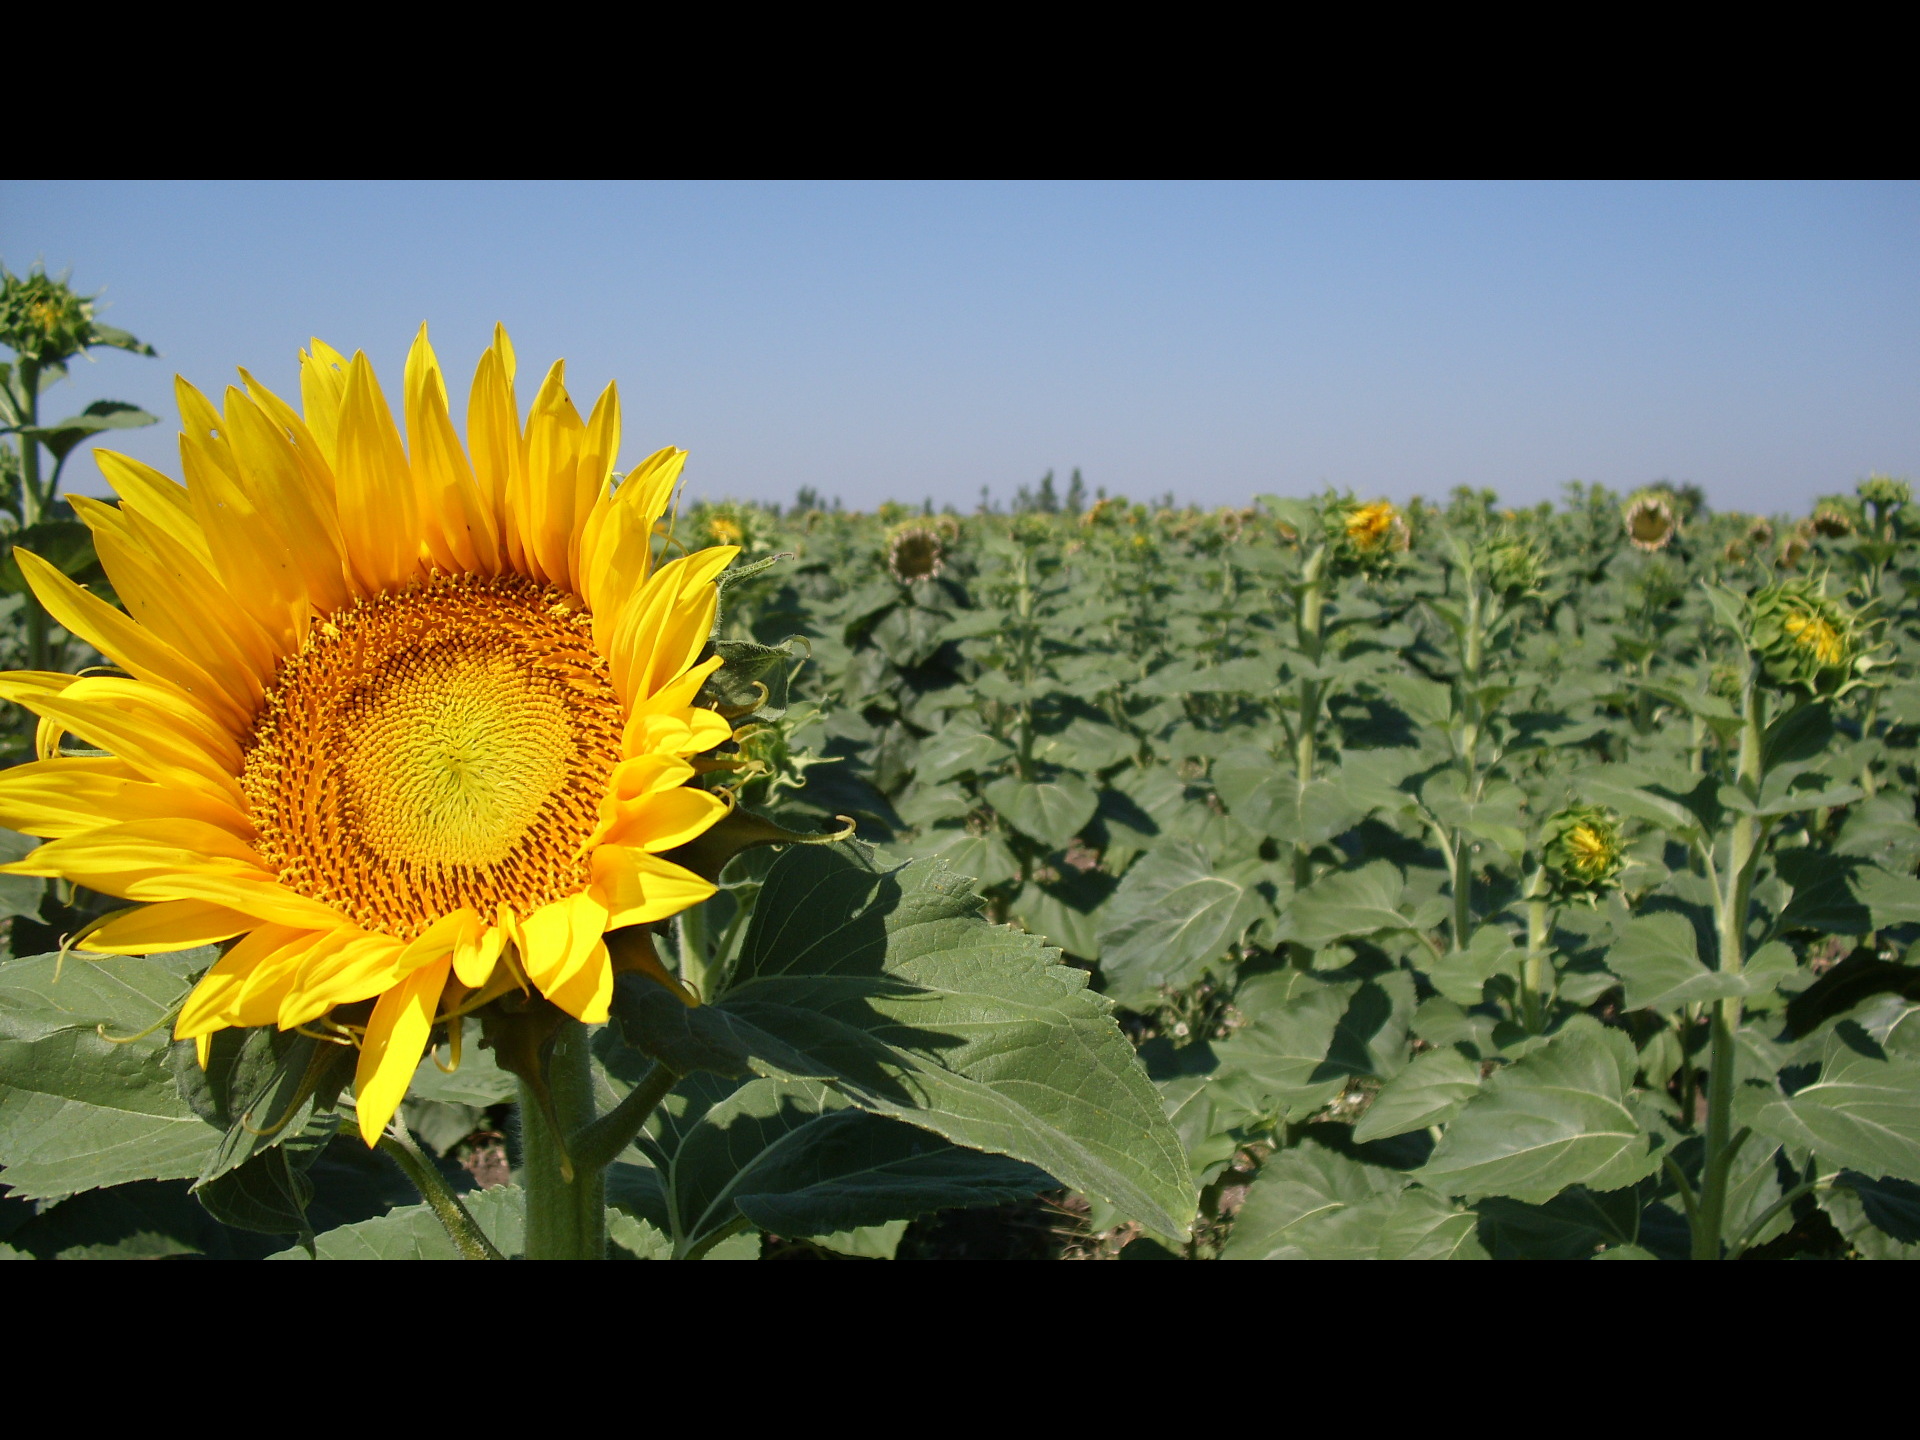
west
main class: Cropland
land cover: Sunflower
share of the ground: > 75 %
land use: Agriculture (excluding fallow land and kitchen gardens)
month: July
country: BG
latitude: 43.8660
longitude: 22.6399
